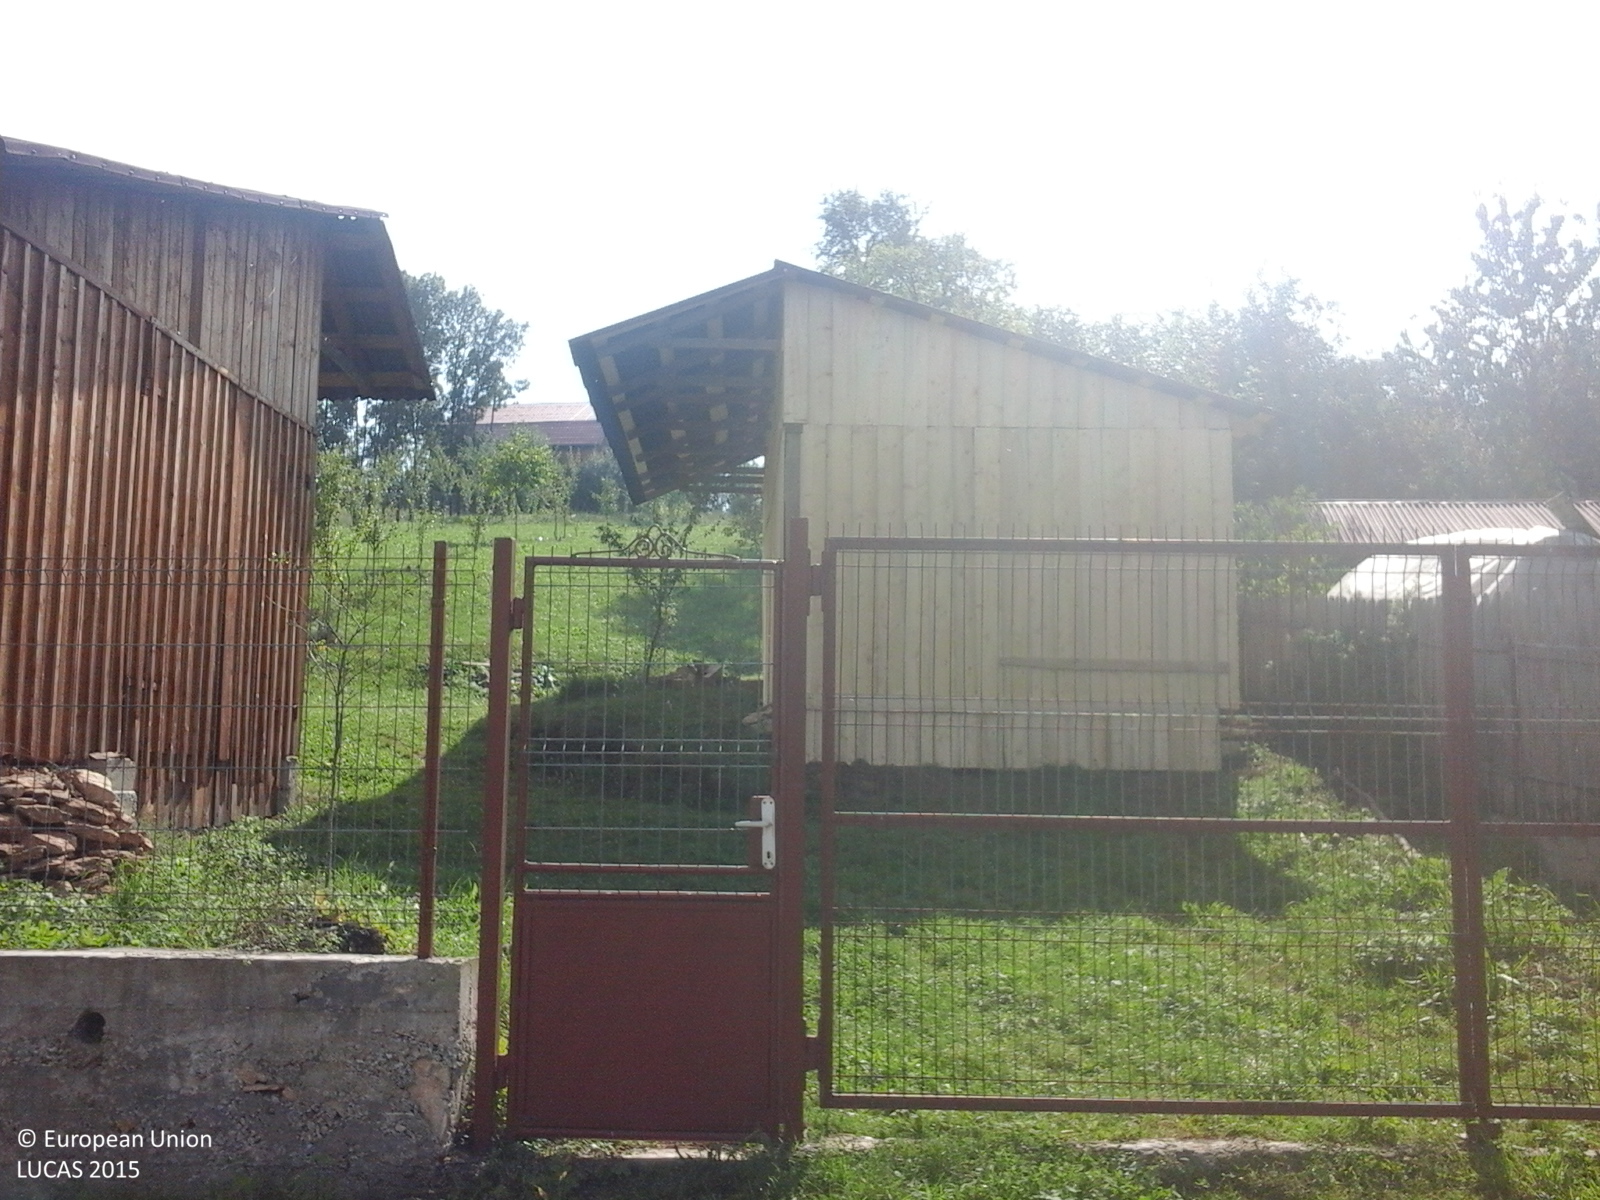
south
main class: Cropland
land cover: Apple fruit
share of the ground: > 75 %
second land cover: Grassland without tree/shrub cover
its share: > 75 %
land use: Agriculture (excluding fallow land and kitchen gardens)
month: September
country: RO
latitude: 46.8079
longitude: 23.1815
